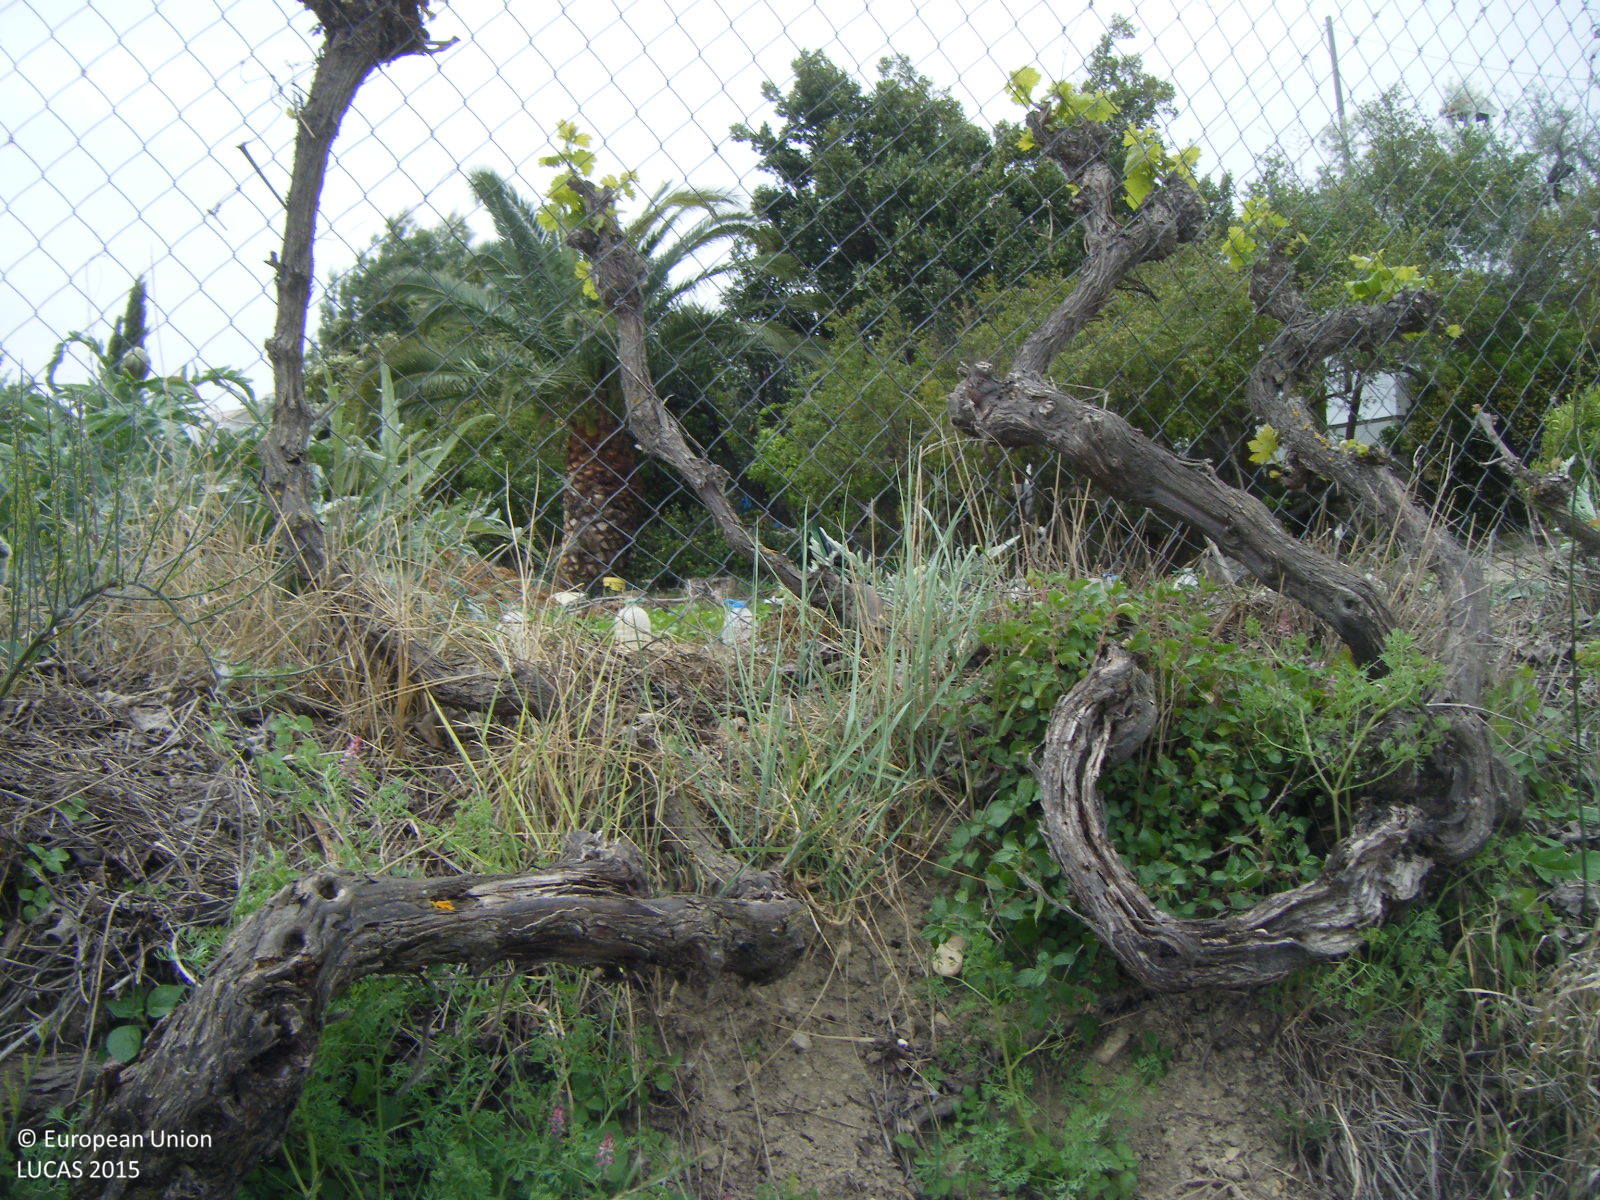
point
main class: Woodland
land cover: Broadleaved woodland
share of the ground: > 75 %
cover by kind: broadleaved forest trees 95 %, coniferous forest trees 5 %
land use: Residential
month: April
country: ES
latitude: 37.1761
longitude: -4.1752
